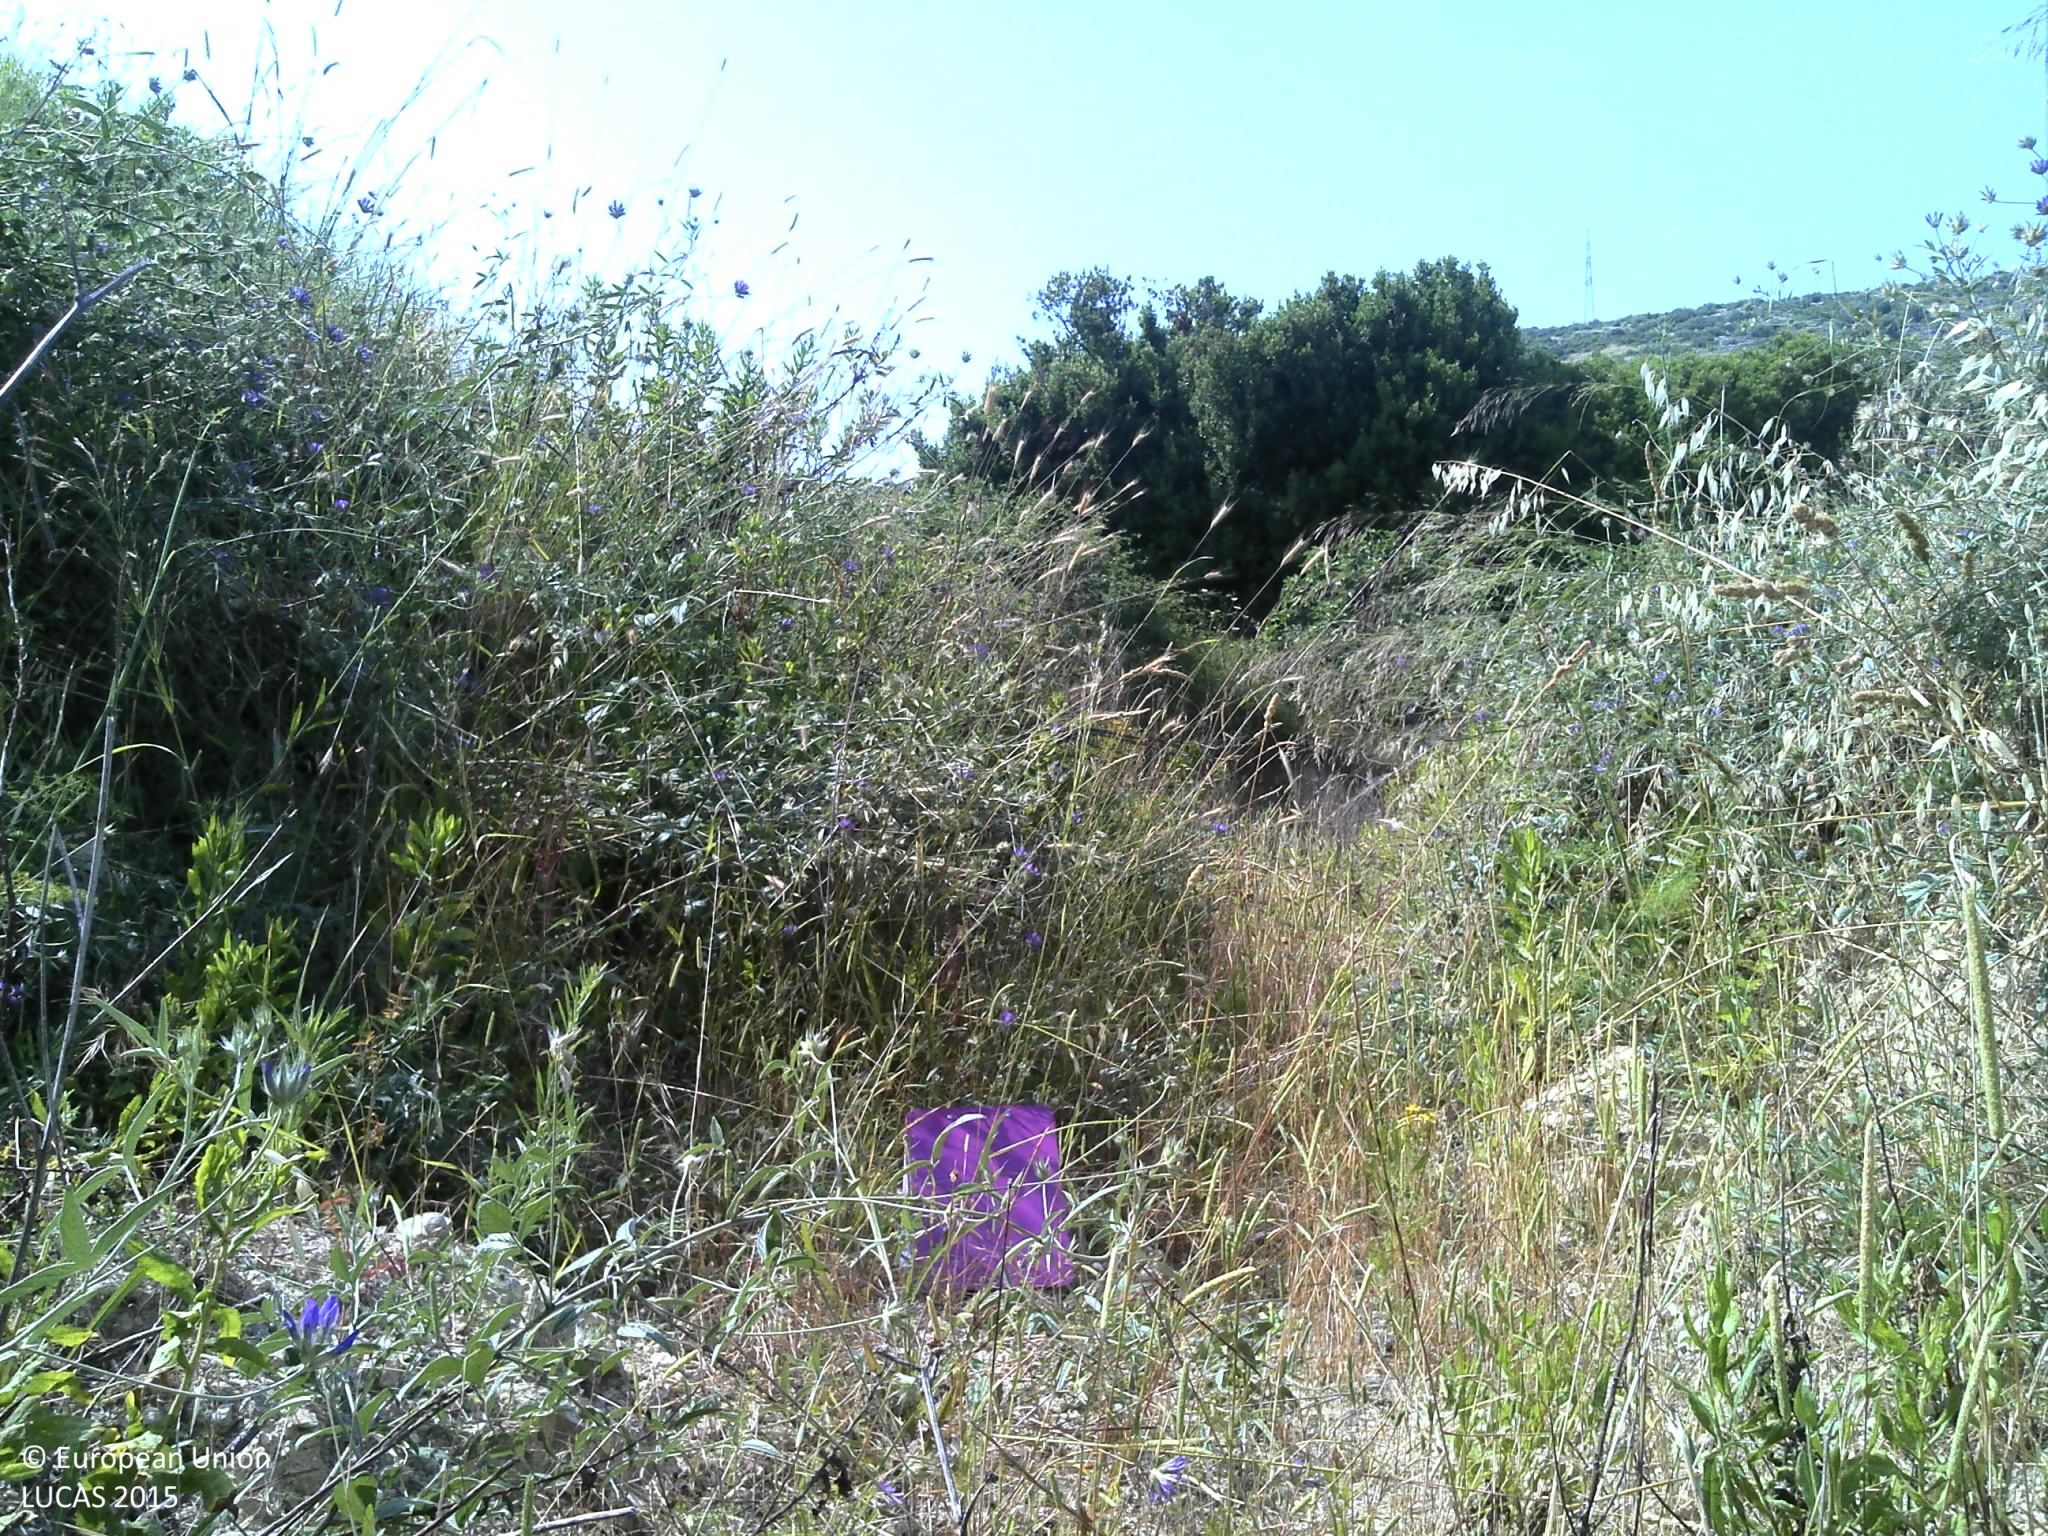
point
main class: Grassland
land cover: Grassland without tree/shrub cover
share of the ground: > 75 %
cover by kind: herbaceous plants 80 %, unconsolidated bare surface 15 %, shrubs 5 %
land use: Abandoned areas
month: June
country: HR
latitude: 43.5281
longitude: 16.2639
